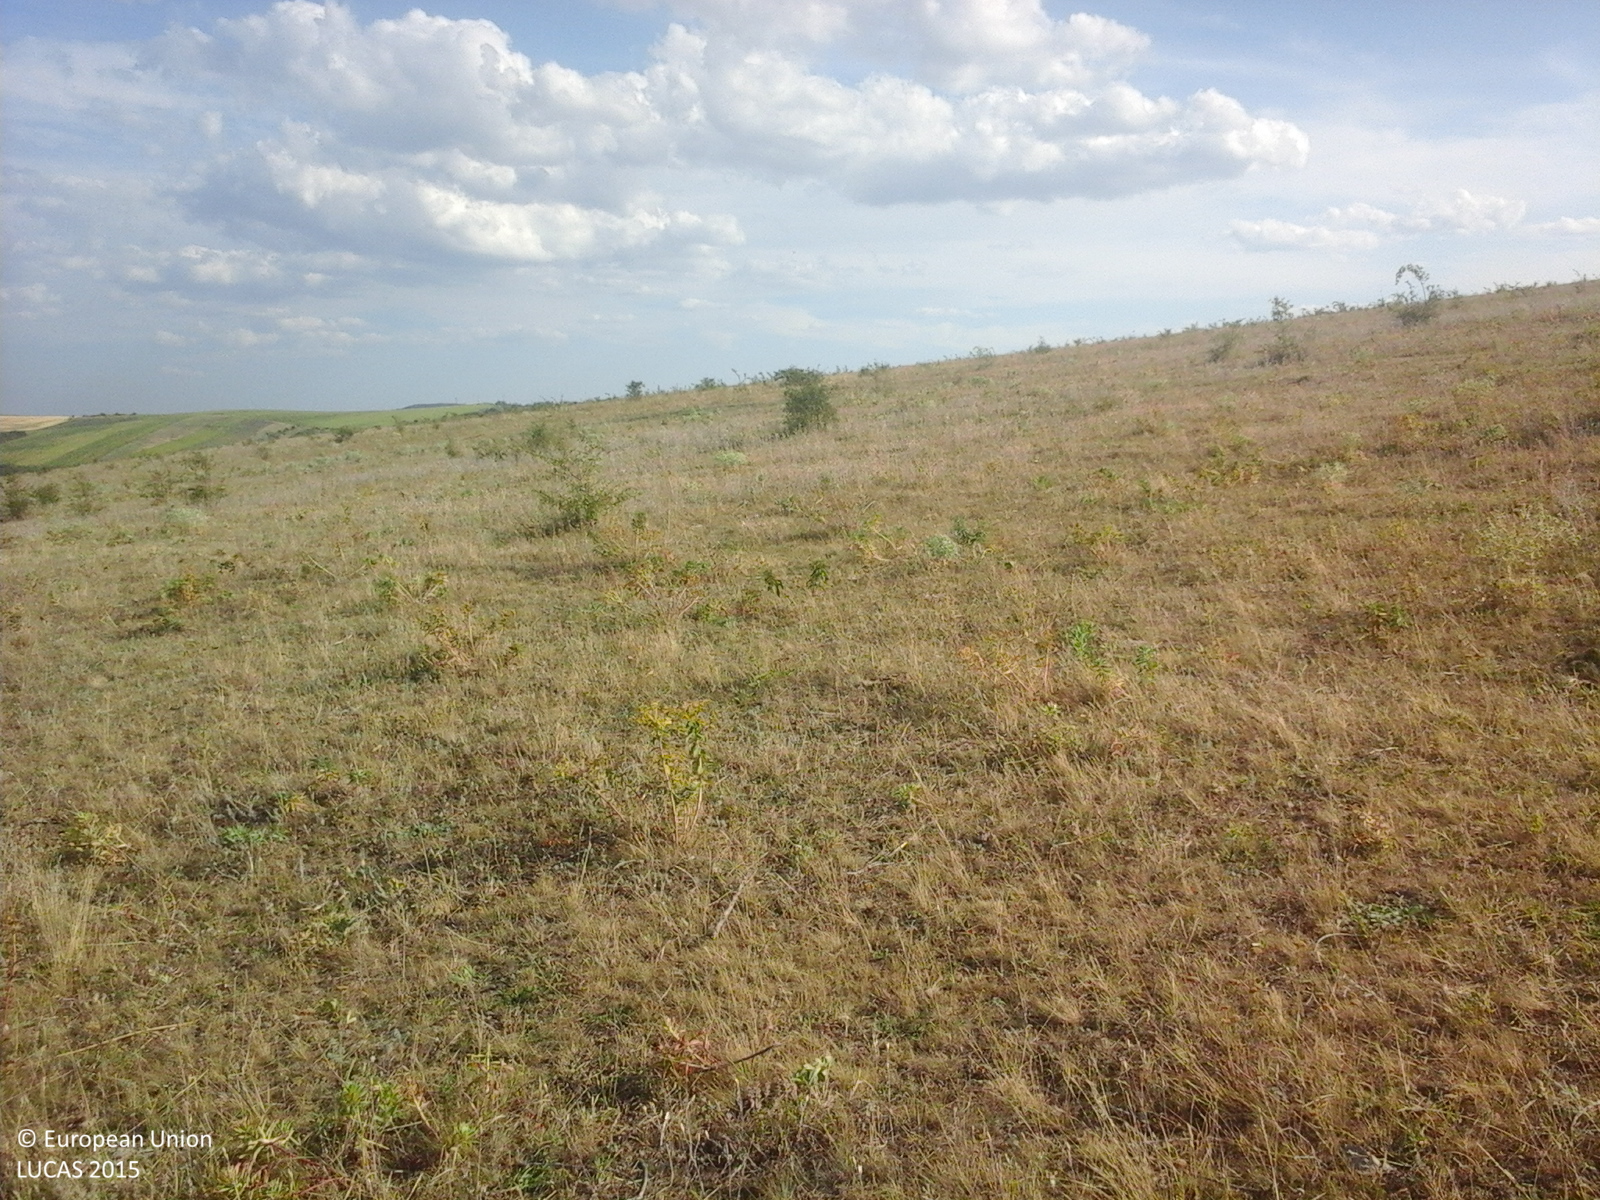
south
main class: Grassland
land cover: Spontaneously vegetated surfaces
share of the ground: > 75 %
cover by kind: herbaceous plants 100 %
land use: Fallow land
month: August
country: RO
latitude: 46.2789
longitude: 27.9144
